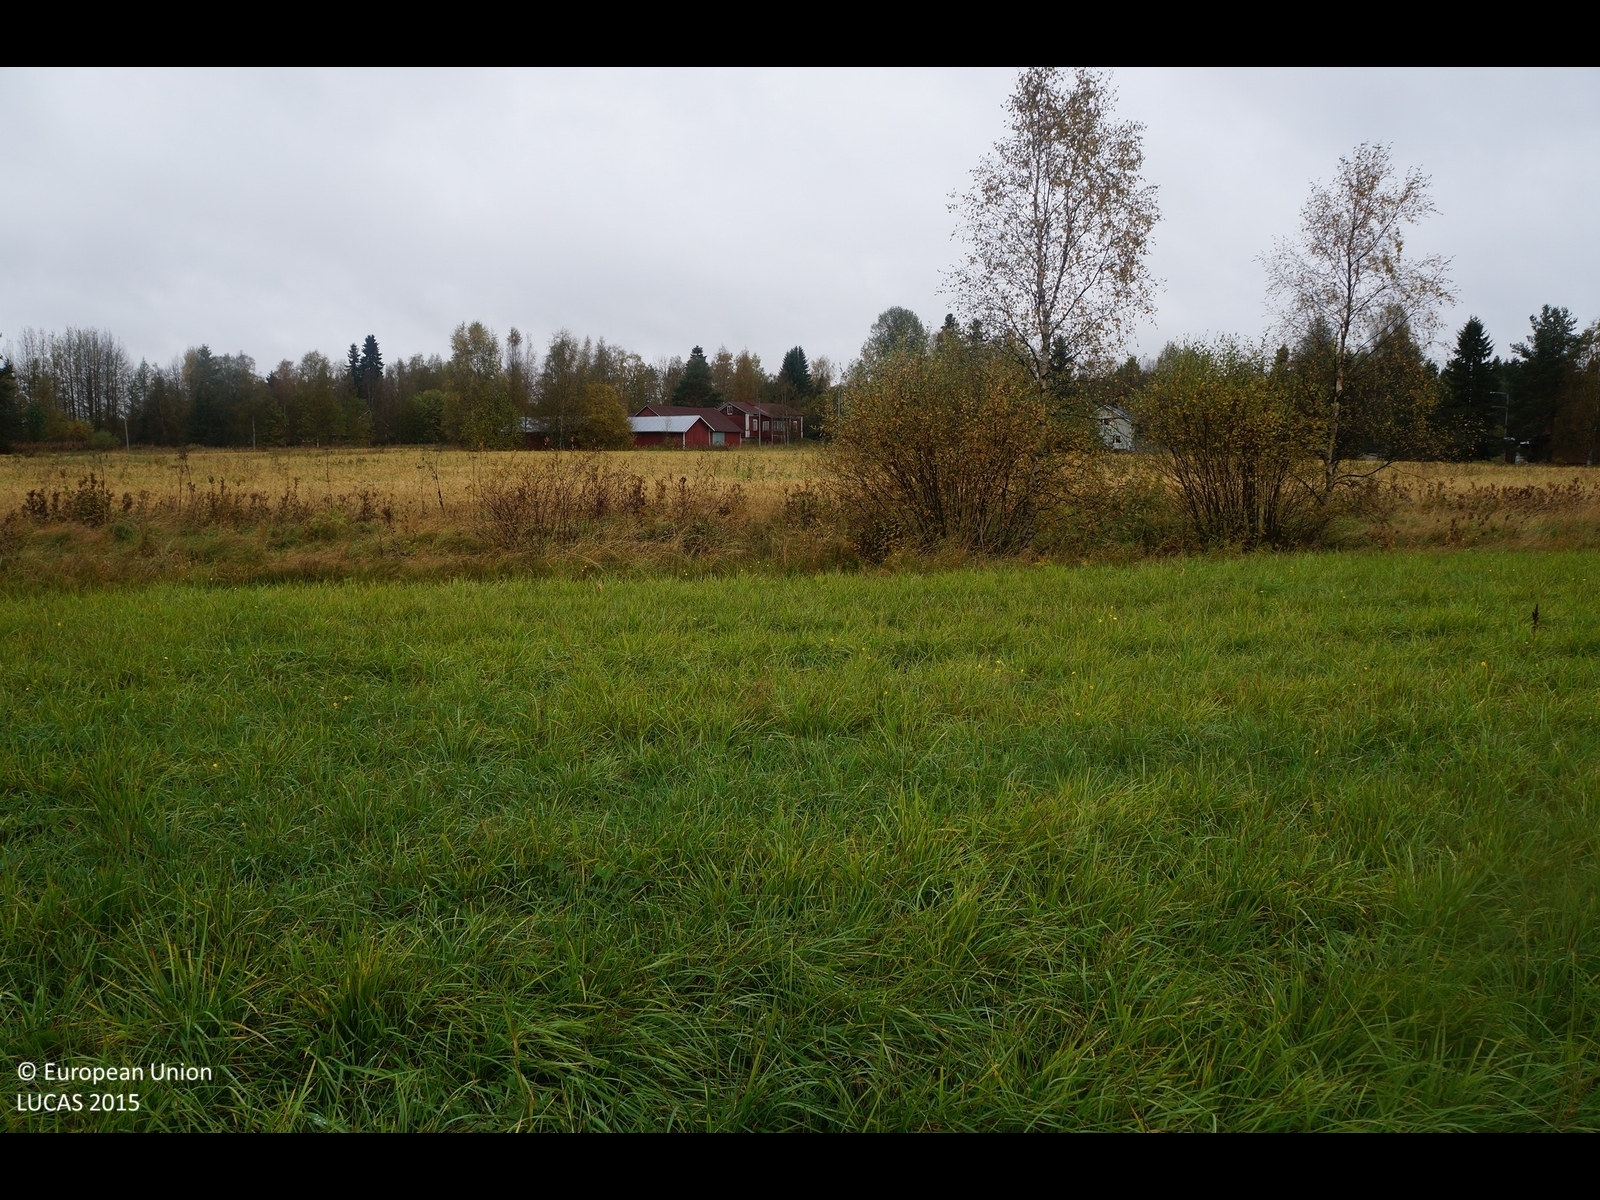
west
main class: Cropland
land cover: Temporary grasslands
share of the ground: > 75 %
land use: Agriculture (excluding fallow land and kitchen gardens)
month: September
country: FI
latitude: 64.0787
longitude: 24.4875
